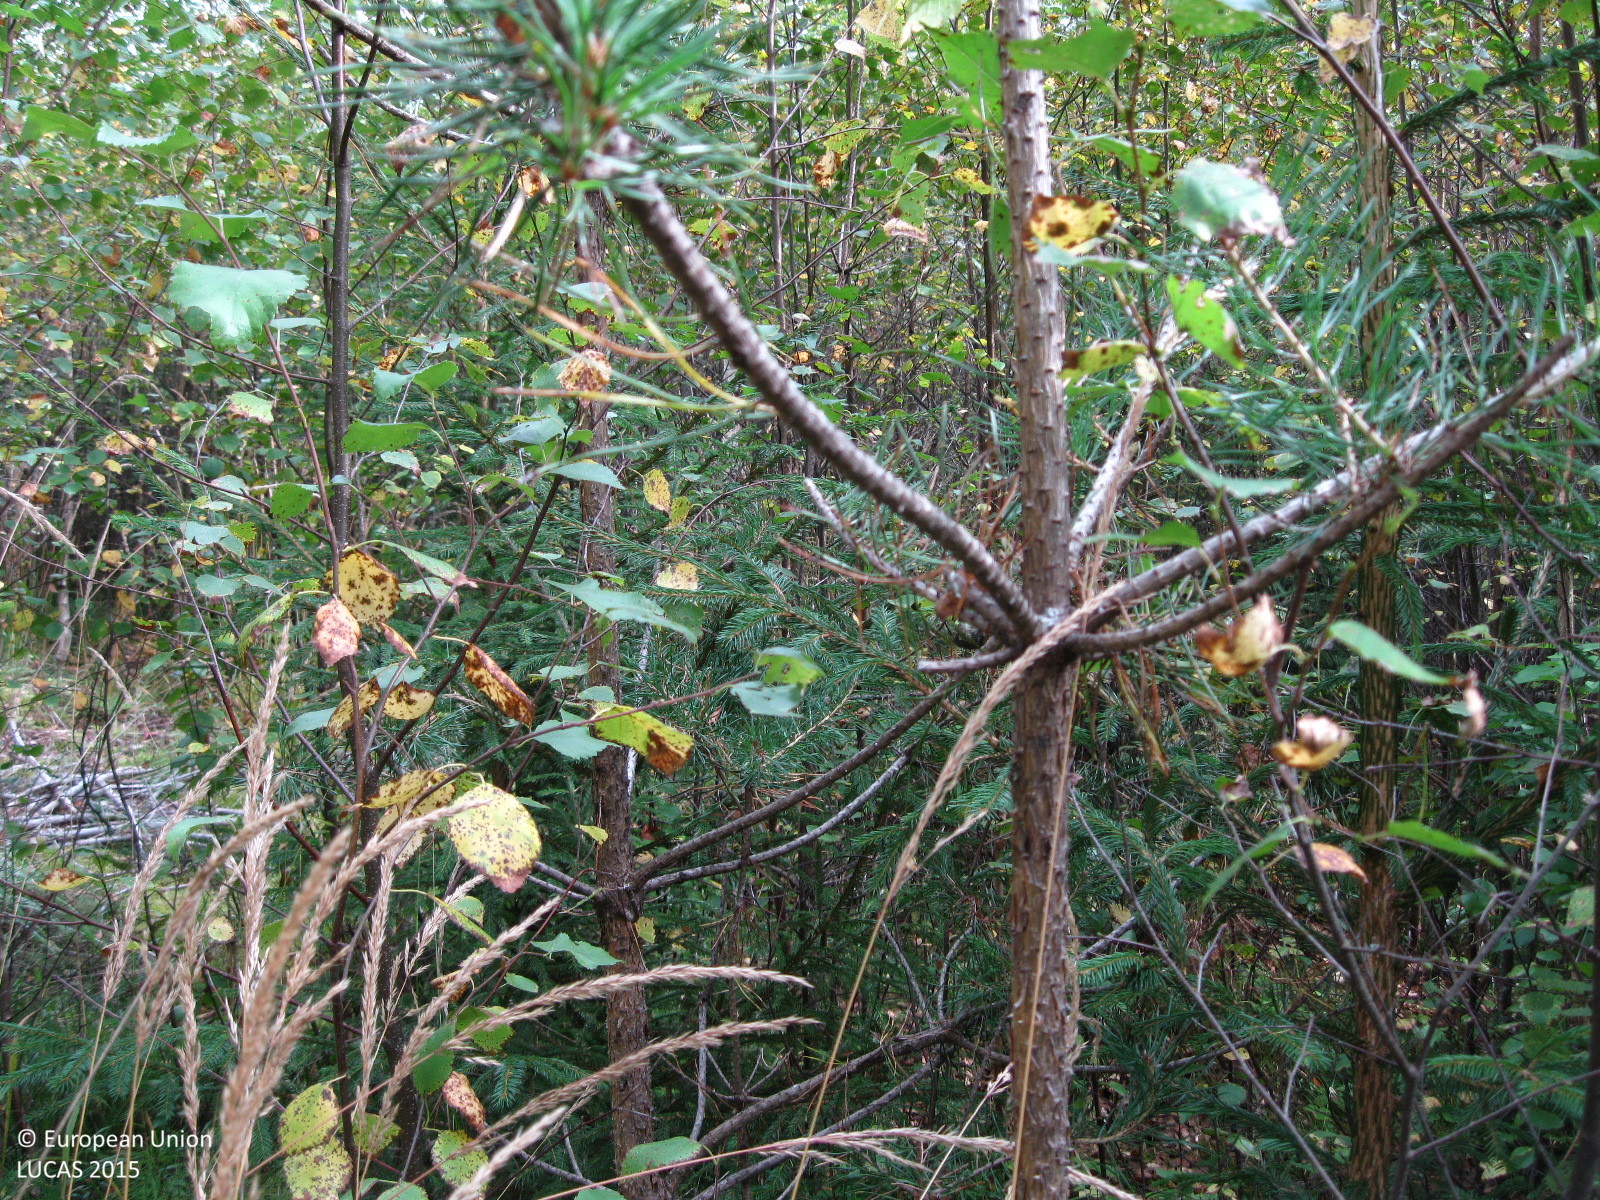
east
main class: Woodland
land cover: Spruce dominated mixed woodland
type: boreal forest
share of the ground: > 75 %
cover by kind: coniferous forest trees 45 %, broadleaved forest trees 35 %, shrubs 10 %, herbaceous plants 10 %
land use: Forestry
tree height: > 5 m
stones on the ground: < 10 %
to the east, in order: Spruce dominated mixed woodland; Broadleaved woodland; Pine dominated mixed woodland; Tracks; Paved roads, cycling and walking lanes; Ditches and canals; Pine dominated mixed woodland; Tracks; Pine dominated mixed woodland; Sand; Pine dominated coniferous woodland; Sand; Pine dominated coniferous woodland
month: September
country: FI
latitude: 60.7196
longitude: 24.9431
